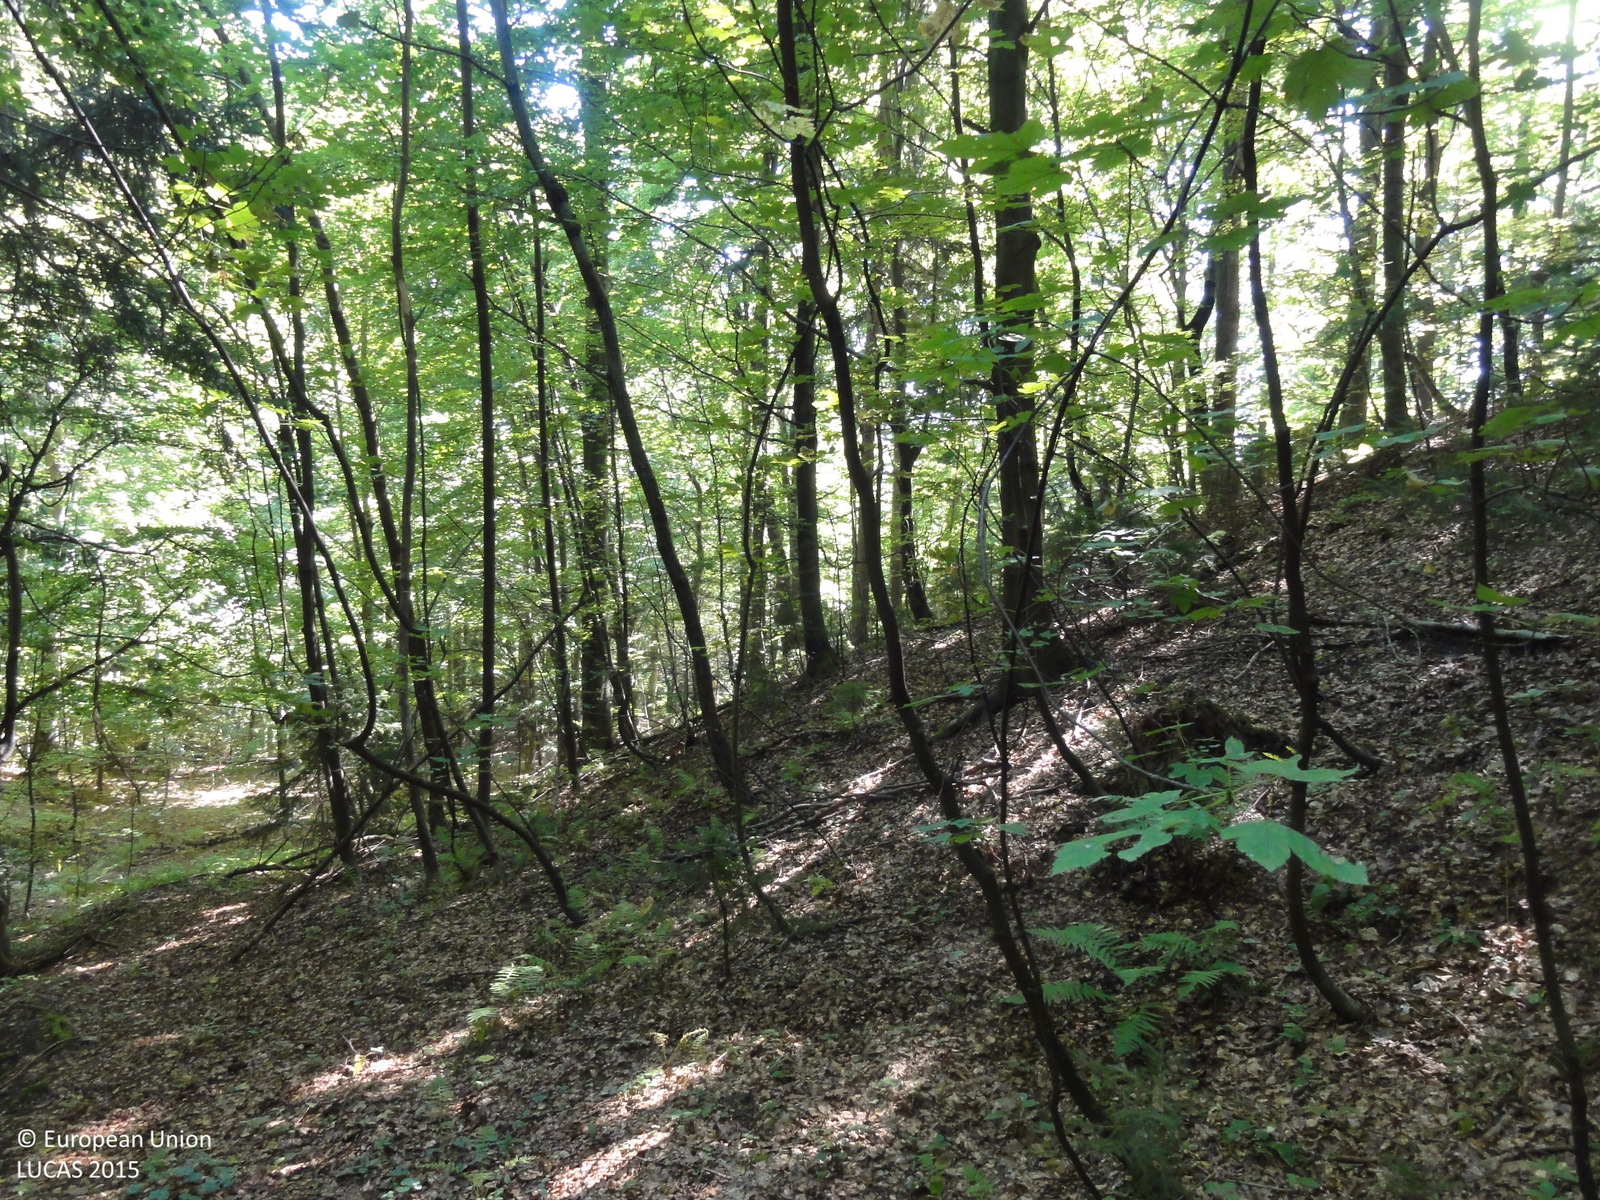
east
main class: Woodland
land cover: Spruce dominated mixed woodland
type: mountainous beech forest
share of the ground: > 75 %
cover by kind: broadleaved forest trees 60 %, coniferous forest trees 25 %, herbaceous plants 10 %, shrubs 5 %
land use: Forestry
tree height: > 5 m
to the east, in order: Spruce dominated mixed woodland; Tracks; Broadleaved woodland; Tracks; Spruce dominated mixed woodland; Spruce dominated coniferous woodland; Tracks; Spruce dominated mixed woodland; Broadleaved woodland
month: August
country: SI
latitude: 46.1556
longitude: 15.1380
